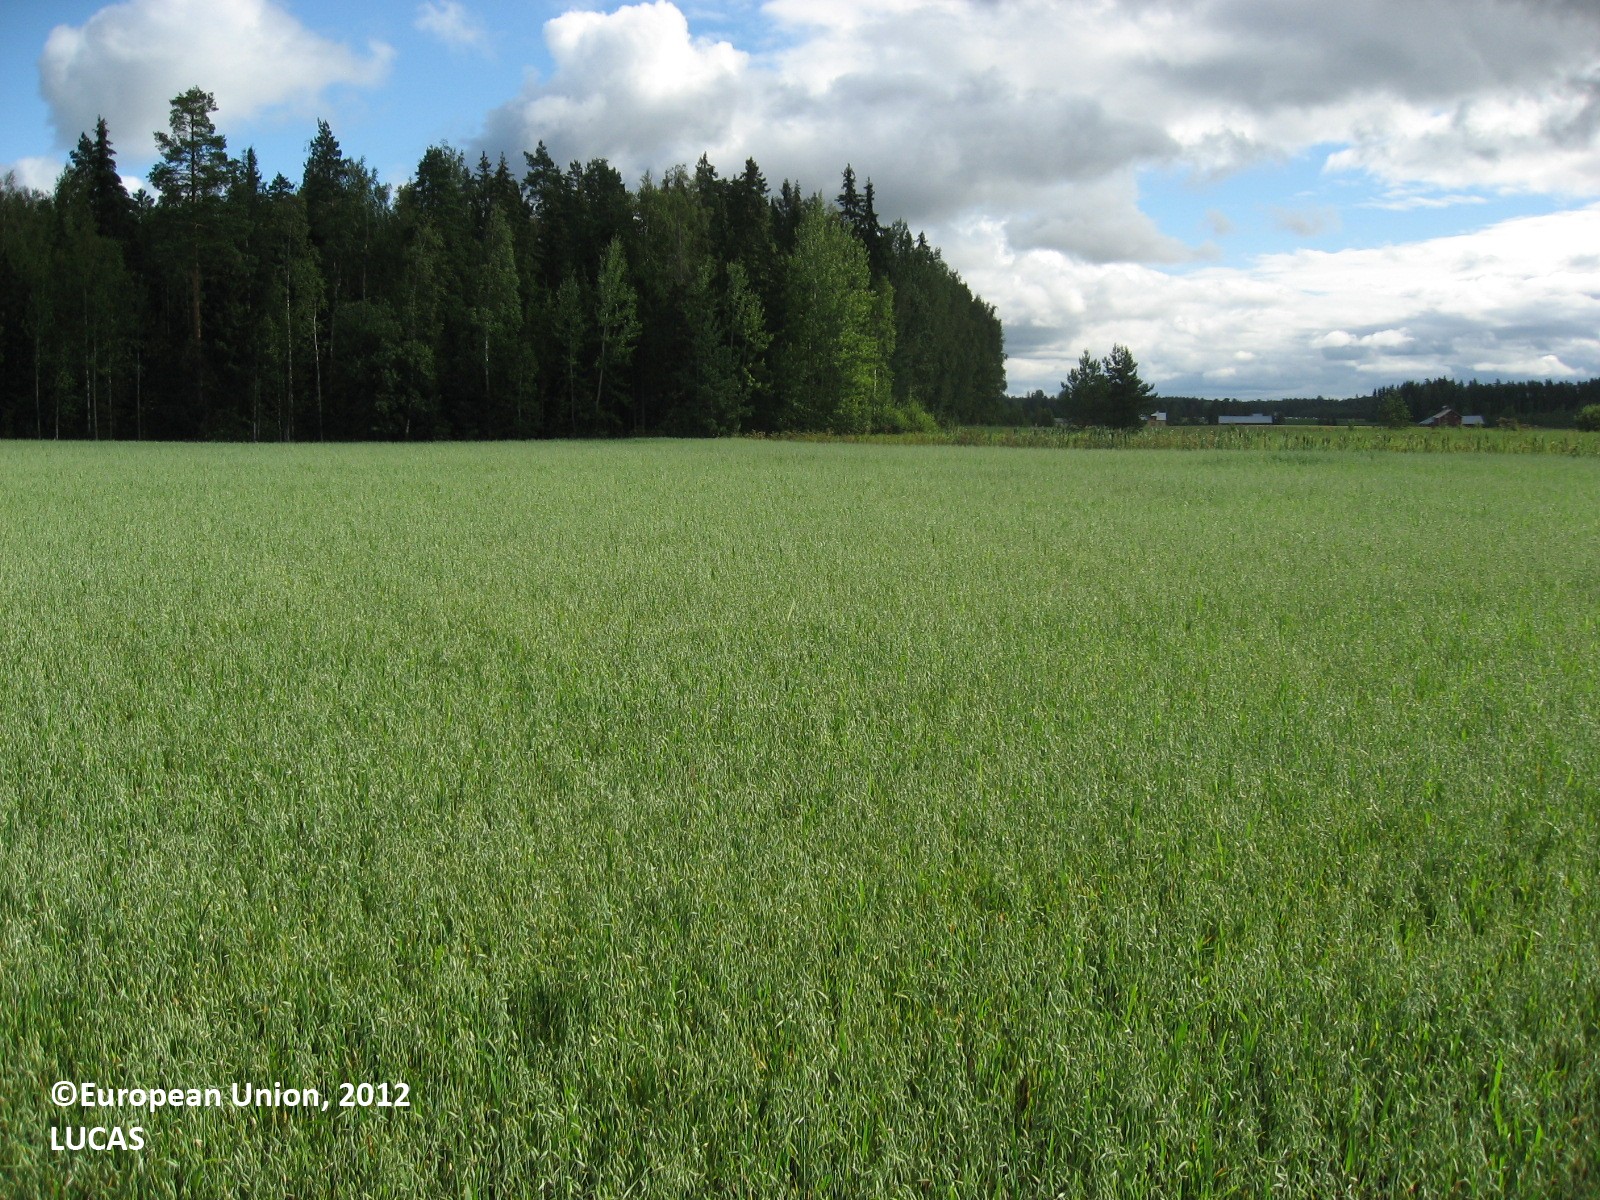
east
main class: Cropland
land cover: Oats
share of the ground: > 75 %
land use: Agriculture (excluding fallow land and kitchen gardens)
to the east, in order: Oats; Grass margins; Ditches and canals; Grass margins; Rape and turnip rape; Grass margins; Ditches and canals; Single bushes/trees; Grass margins; Common wheat
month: August
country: FI
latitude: 60.6445
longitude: 25.4702
